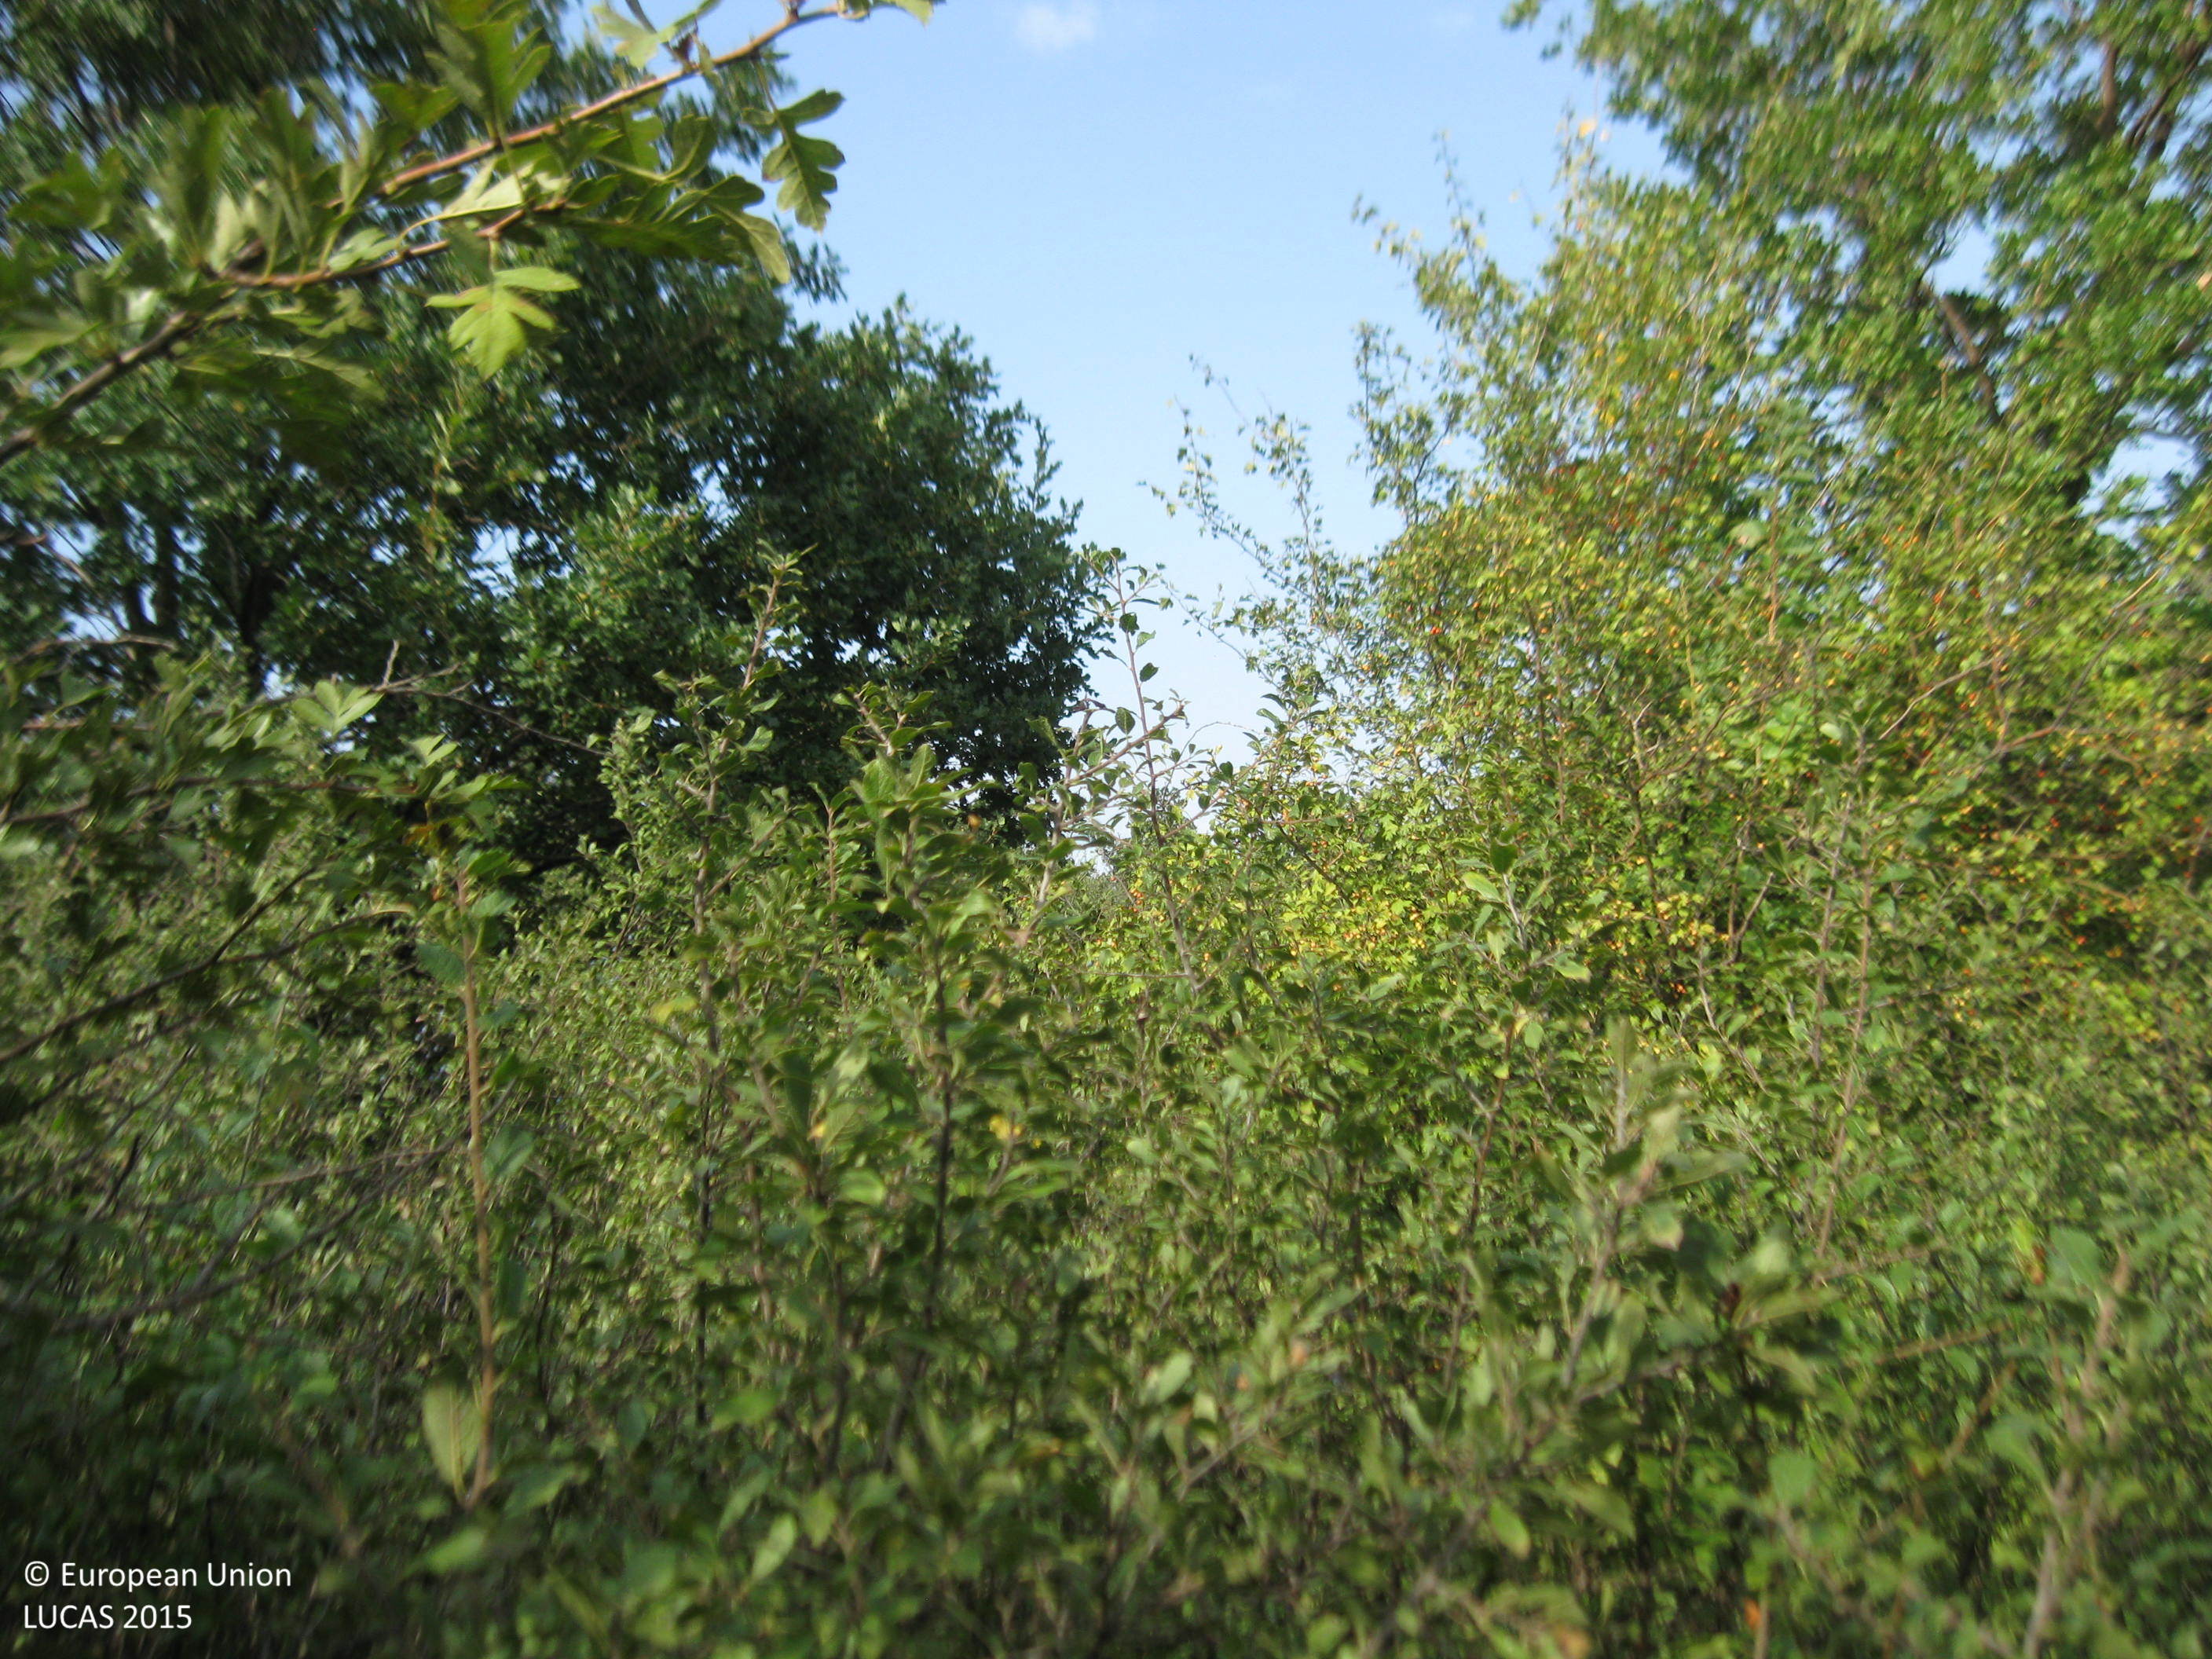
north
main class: Shrubland
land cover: Shrubland with sparse tree cover
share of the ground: > 75 %
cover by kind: shrubs 90 %, broadleaved forest trees 5 %, herbaceous plants 5 %
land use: Abandoned areas
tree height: < 5 m
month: September
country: BG
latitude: 42.1175
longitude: 24.9930
